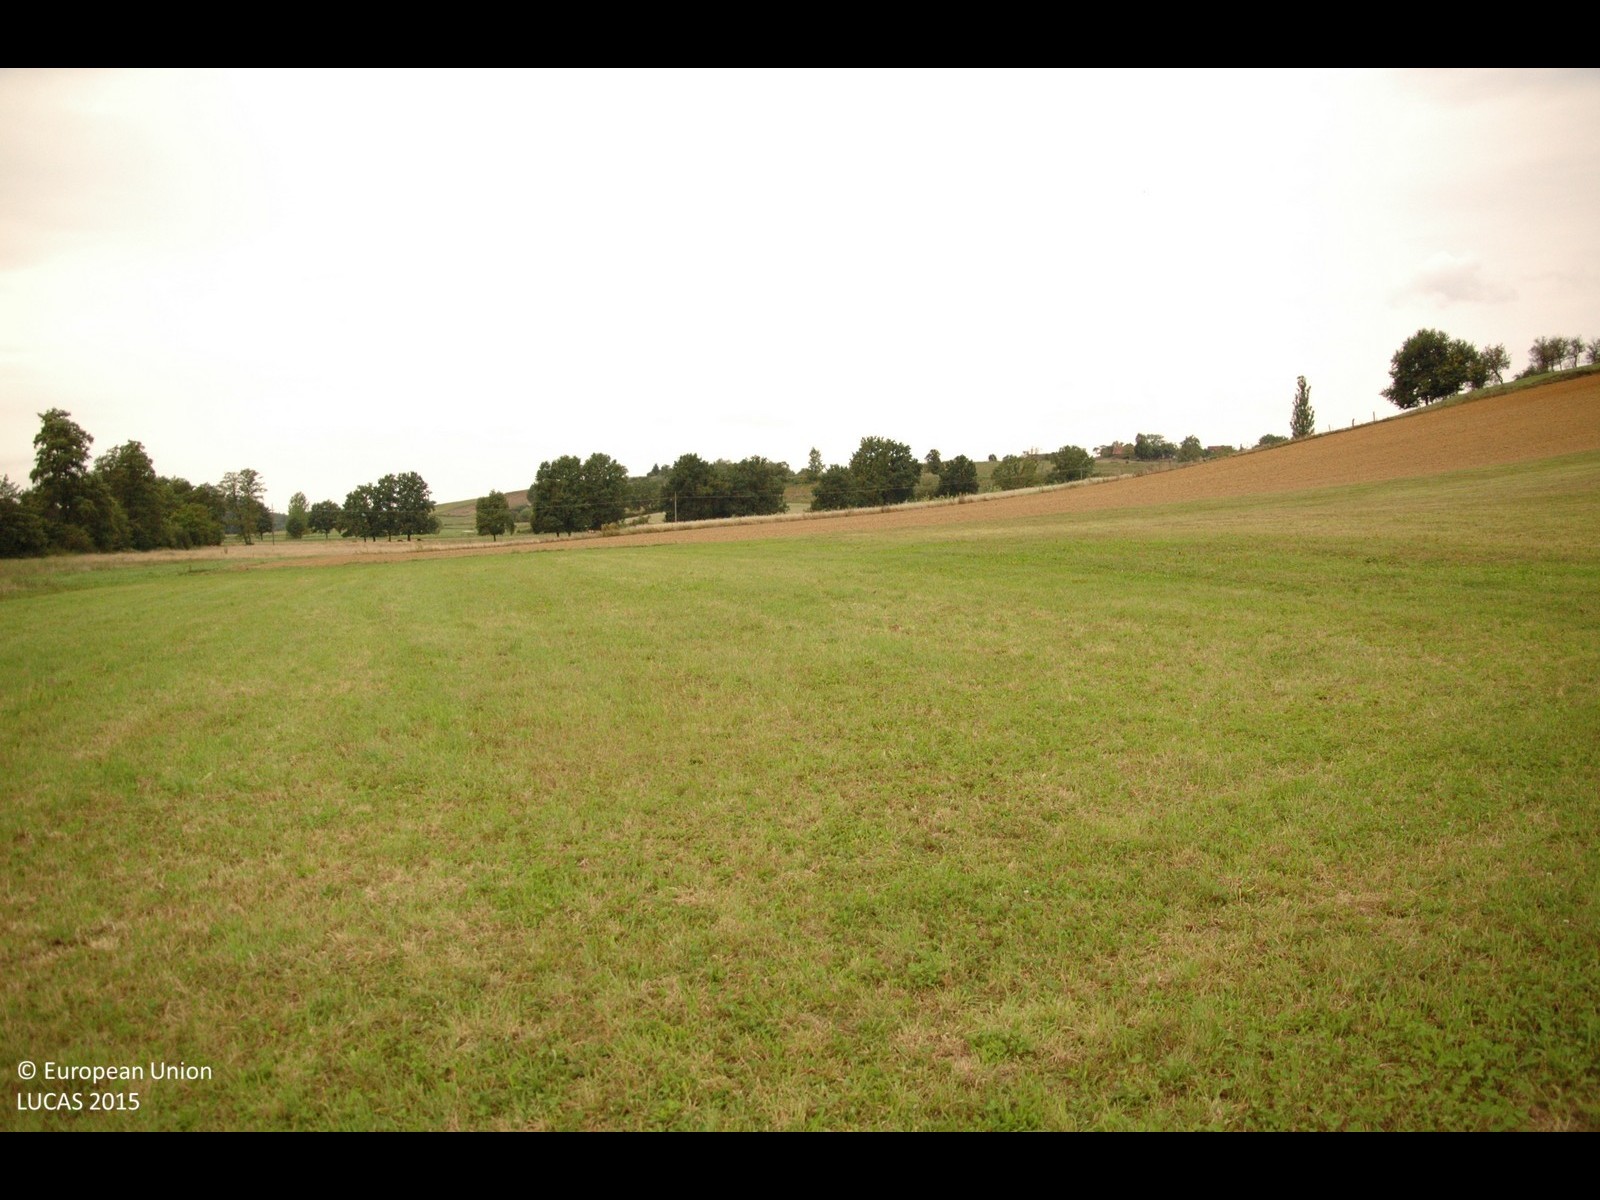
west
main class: Grassland
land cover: Grassland without tree/shrub cover
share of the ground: > 75 %
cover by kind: herbaceous plants 100 %
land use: Agriculture (excluding fallow land and kitchen gardens)
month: September
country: HR
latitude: 46.0649
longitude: 16.7618
